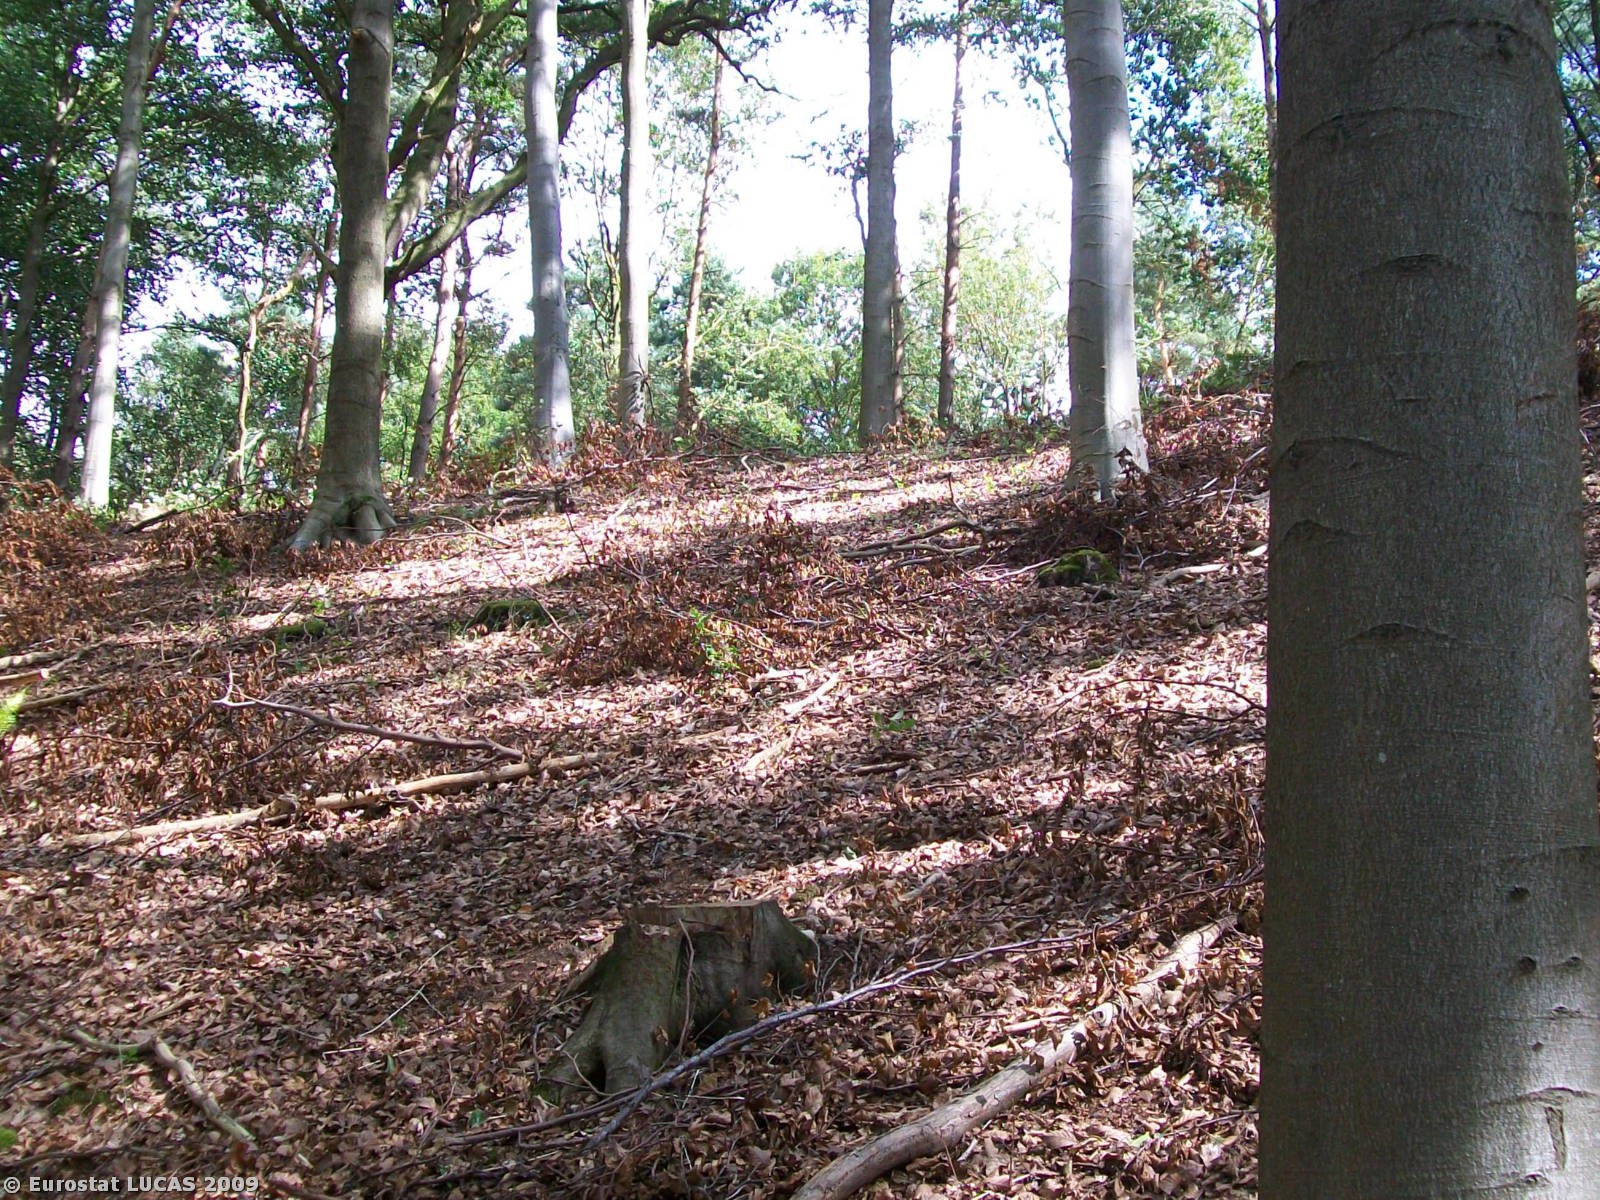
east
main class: Woodland
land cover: Broadleaved woodland
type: mesophytic deciduous forest
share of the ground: > 75 %
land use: Forestry
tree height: > 5 m
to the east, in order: Broadleaved woodland; Coniferous woodland
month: August
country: GB
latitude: 51.9794
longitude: -2.3963
